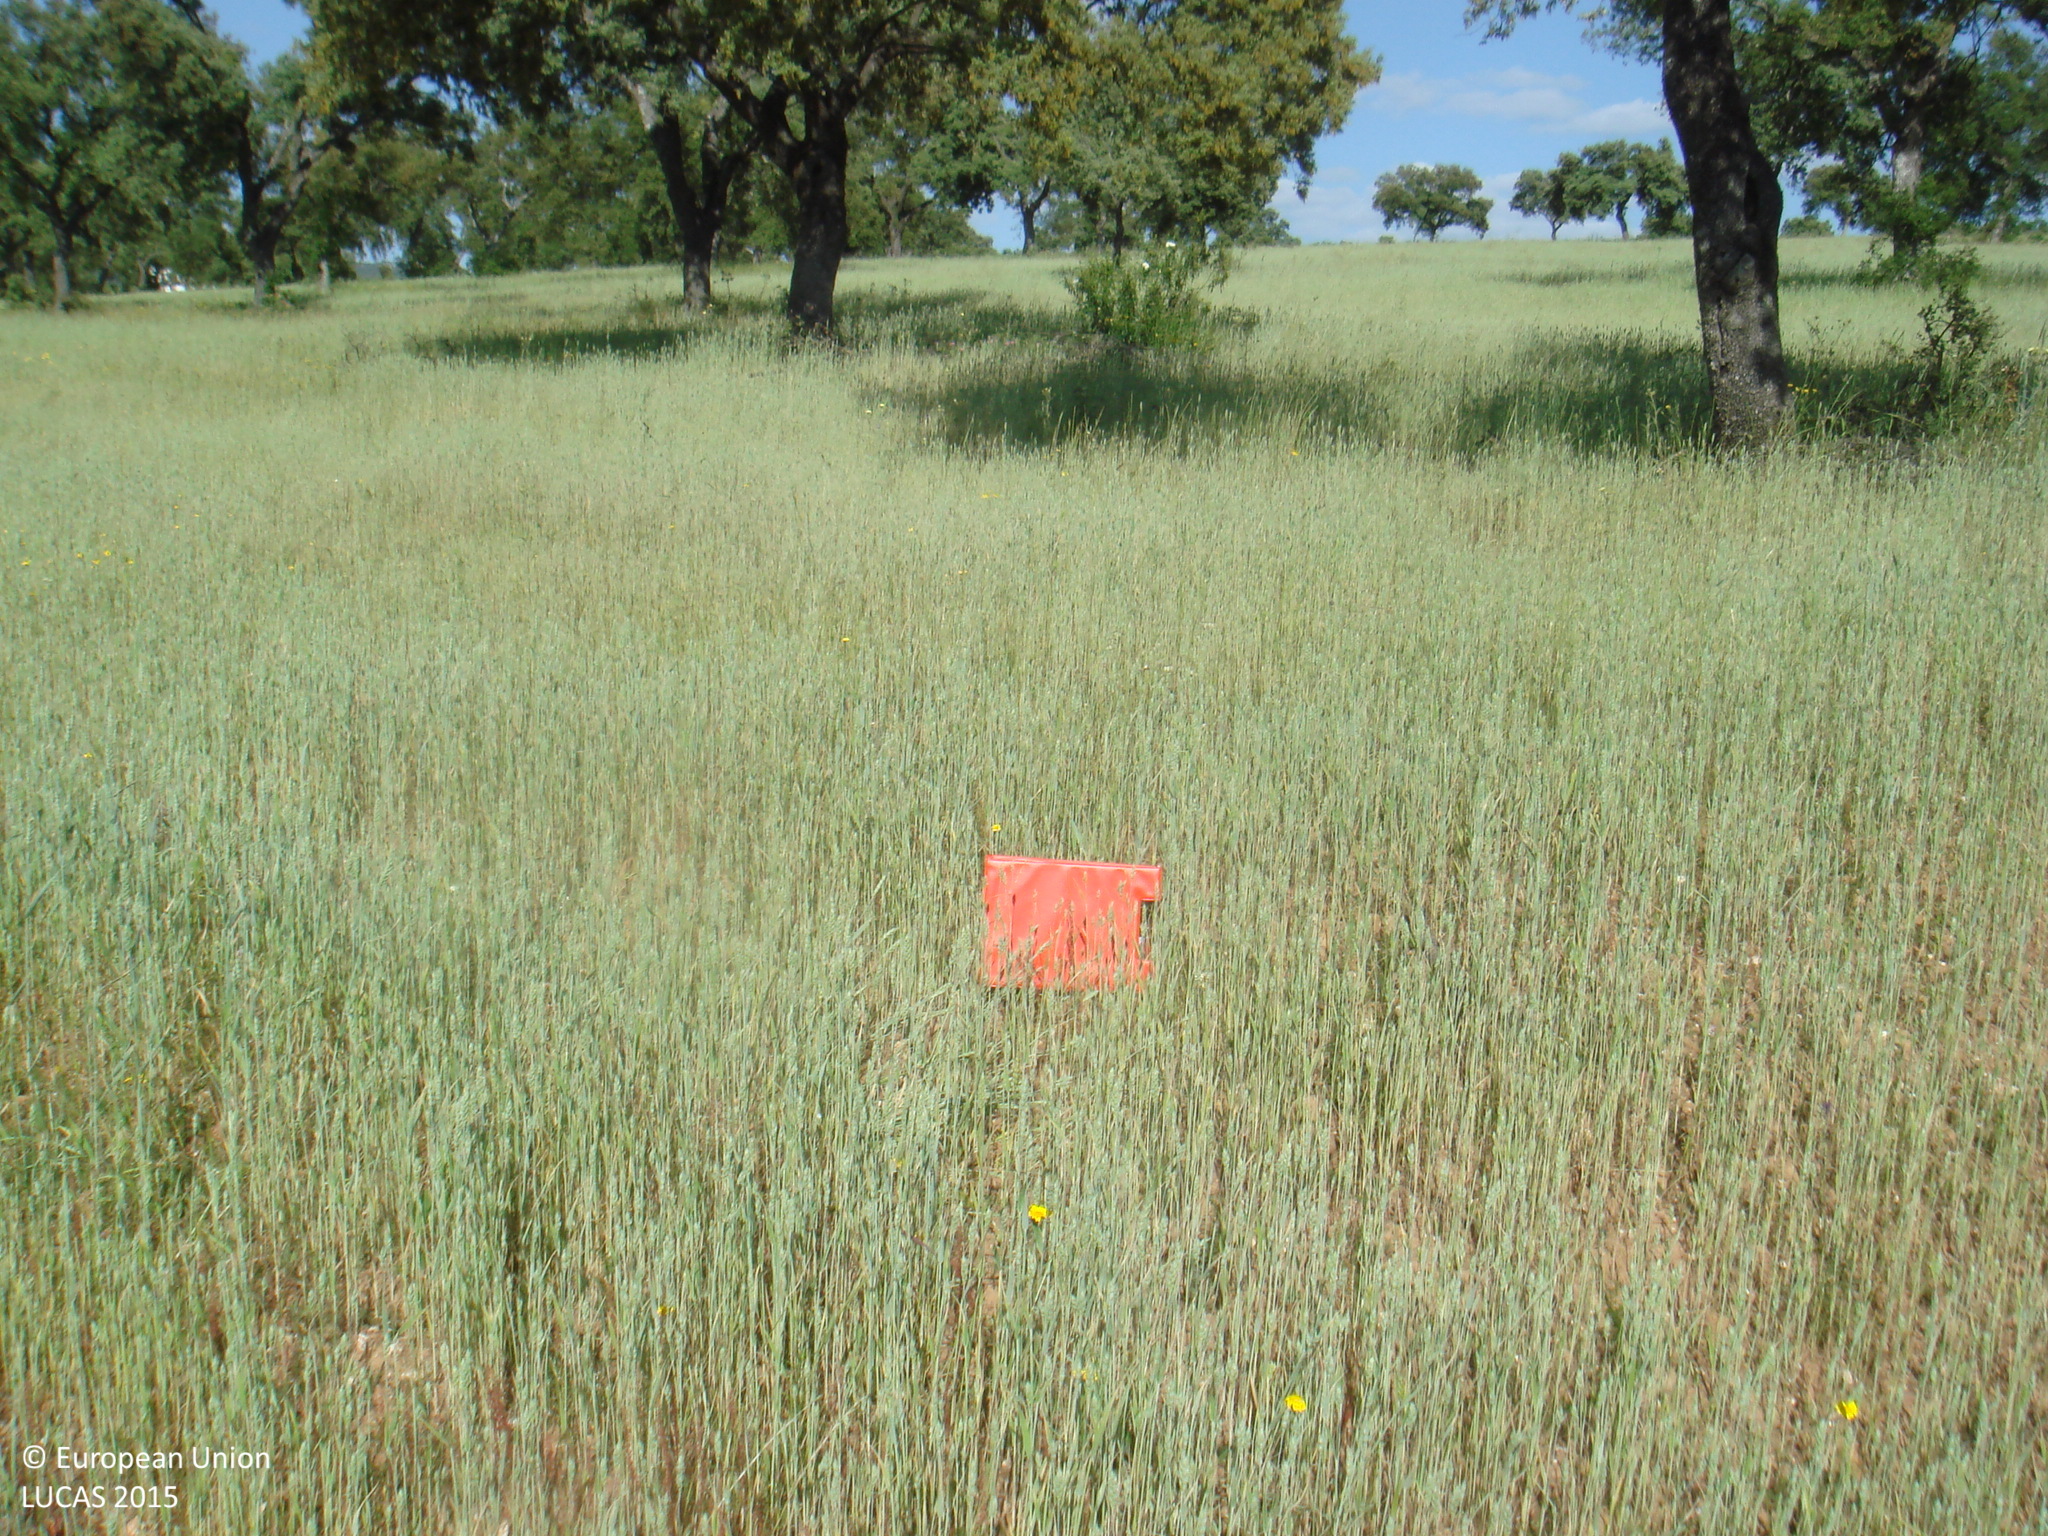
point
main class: Woodland
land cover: Broadleaved woodland
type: broadleaved evergreen forest
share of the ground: 50 - 75 %
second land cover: Common wheat
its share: > 75 %
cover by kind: herbaceous plants 60 %, broadleaved forest trees 40 %
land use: Forestry
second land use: Agriculture (excluding fallow land and kitchen gardens)
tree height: > 5 m
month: May
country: ES
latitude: 38.3966
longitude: -4.3640
